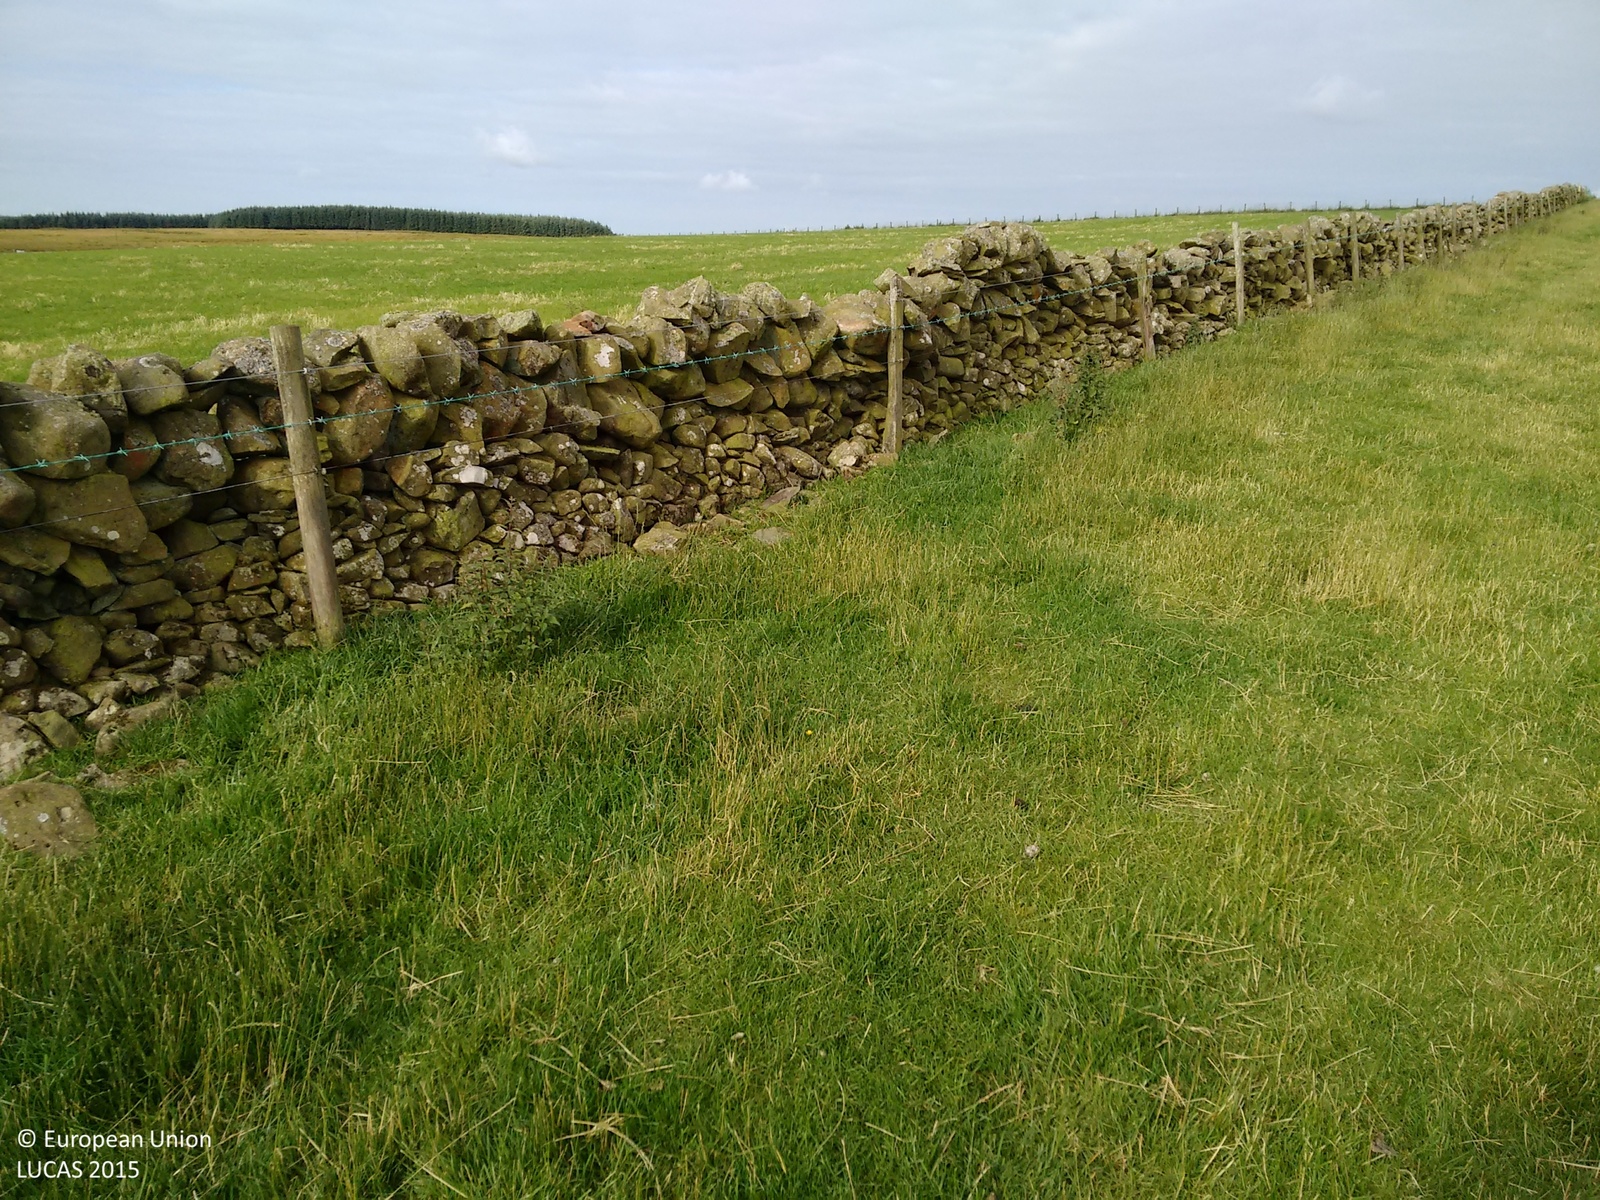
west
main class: Grassland
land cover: Grassland without tree/shrub cover
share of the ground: > 75 %
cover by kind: herbaceous plants 100 %
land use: Agriculture (excluding fallow land and kitchen gardens)
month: August
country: GB
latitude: 54.9237
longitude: -4.9193
